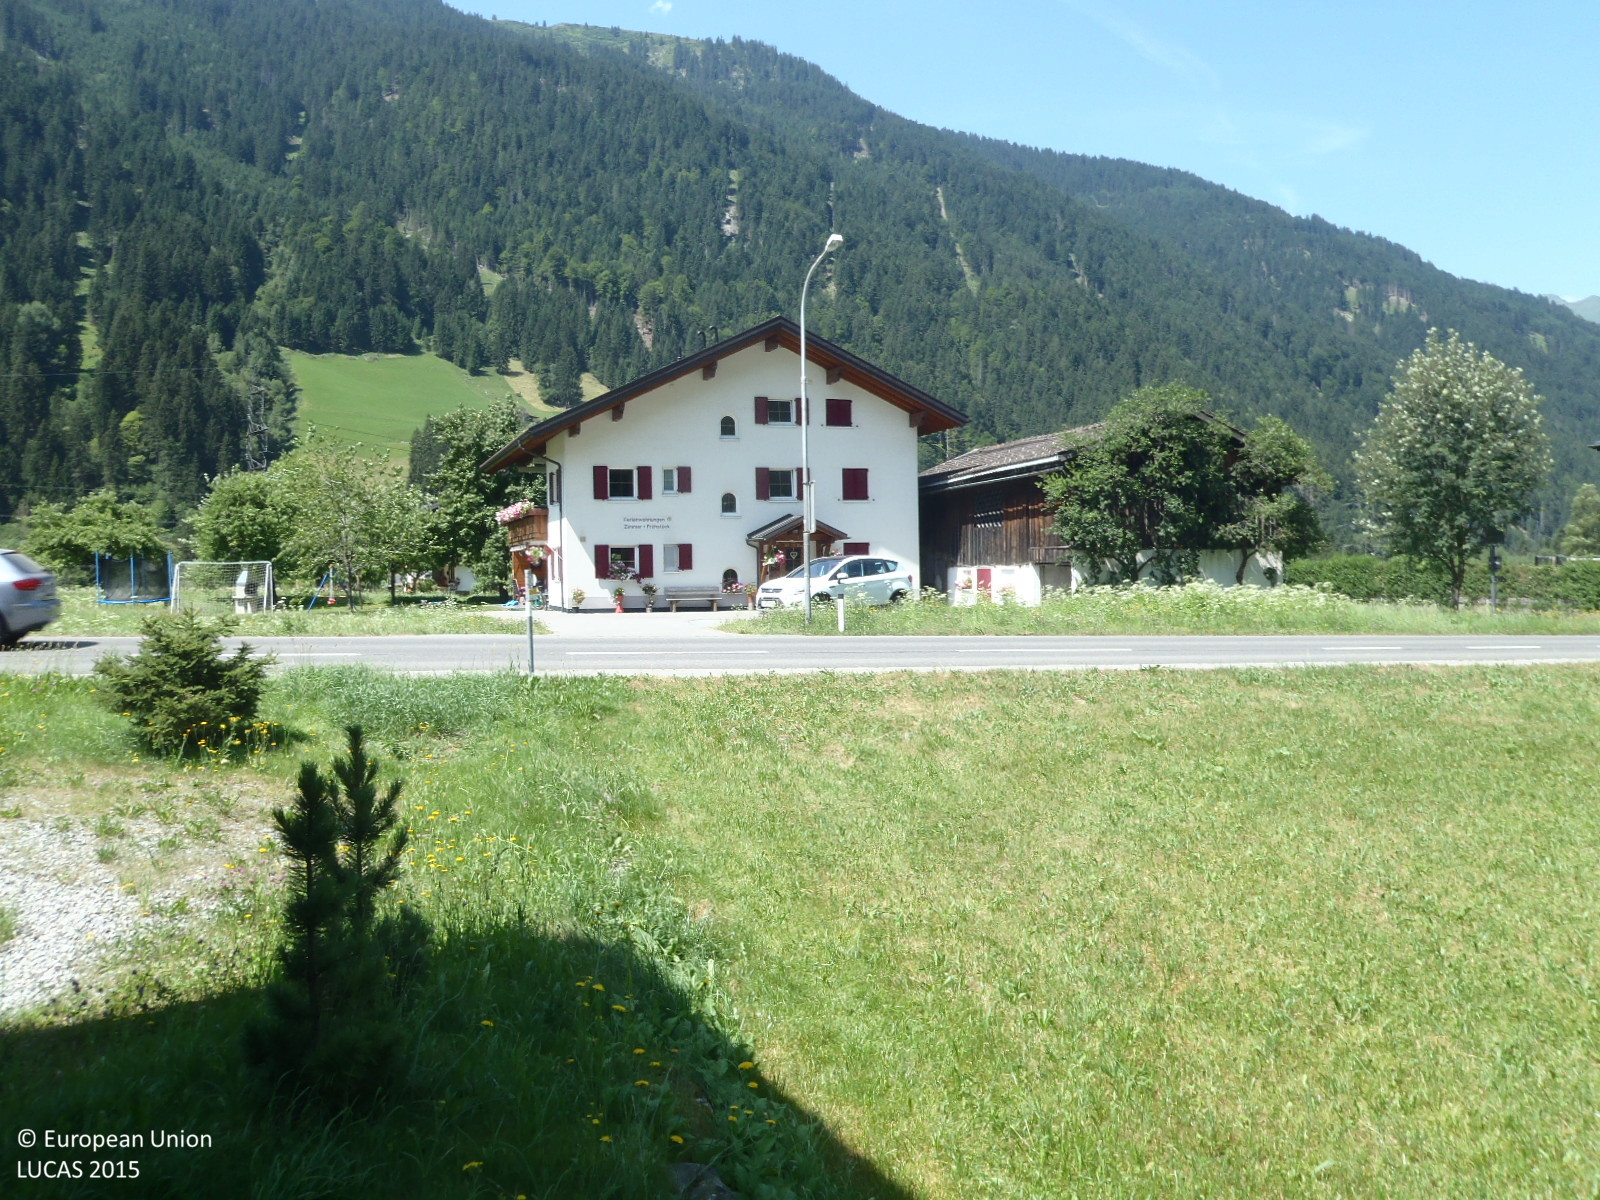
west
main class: Grassland
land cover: Grassland without tree/shrub cover
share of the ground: > 75 %
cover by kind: herbaceous plants 100 %
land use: Residential
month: July
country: AT
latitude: 46.9995
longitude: 10.0131
